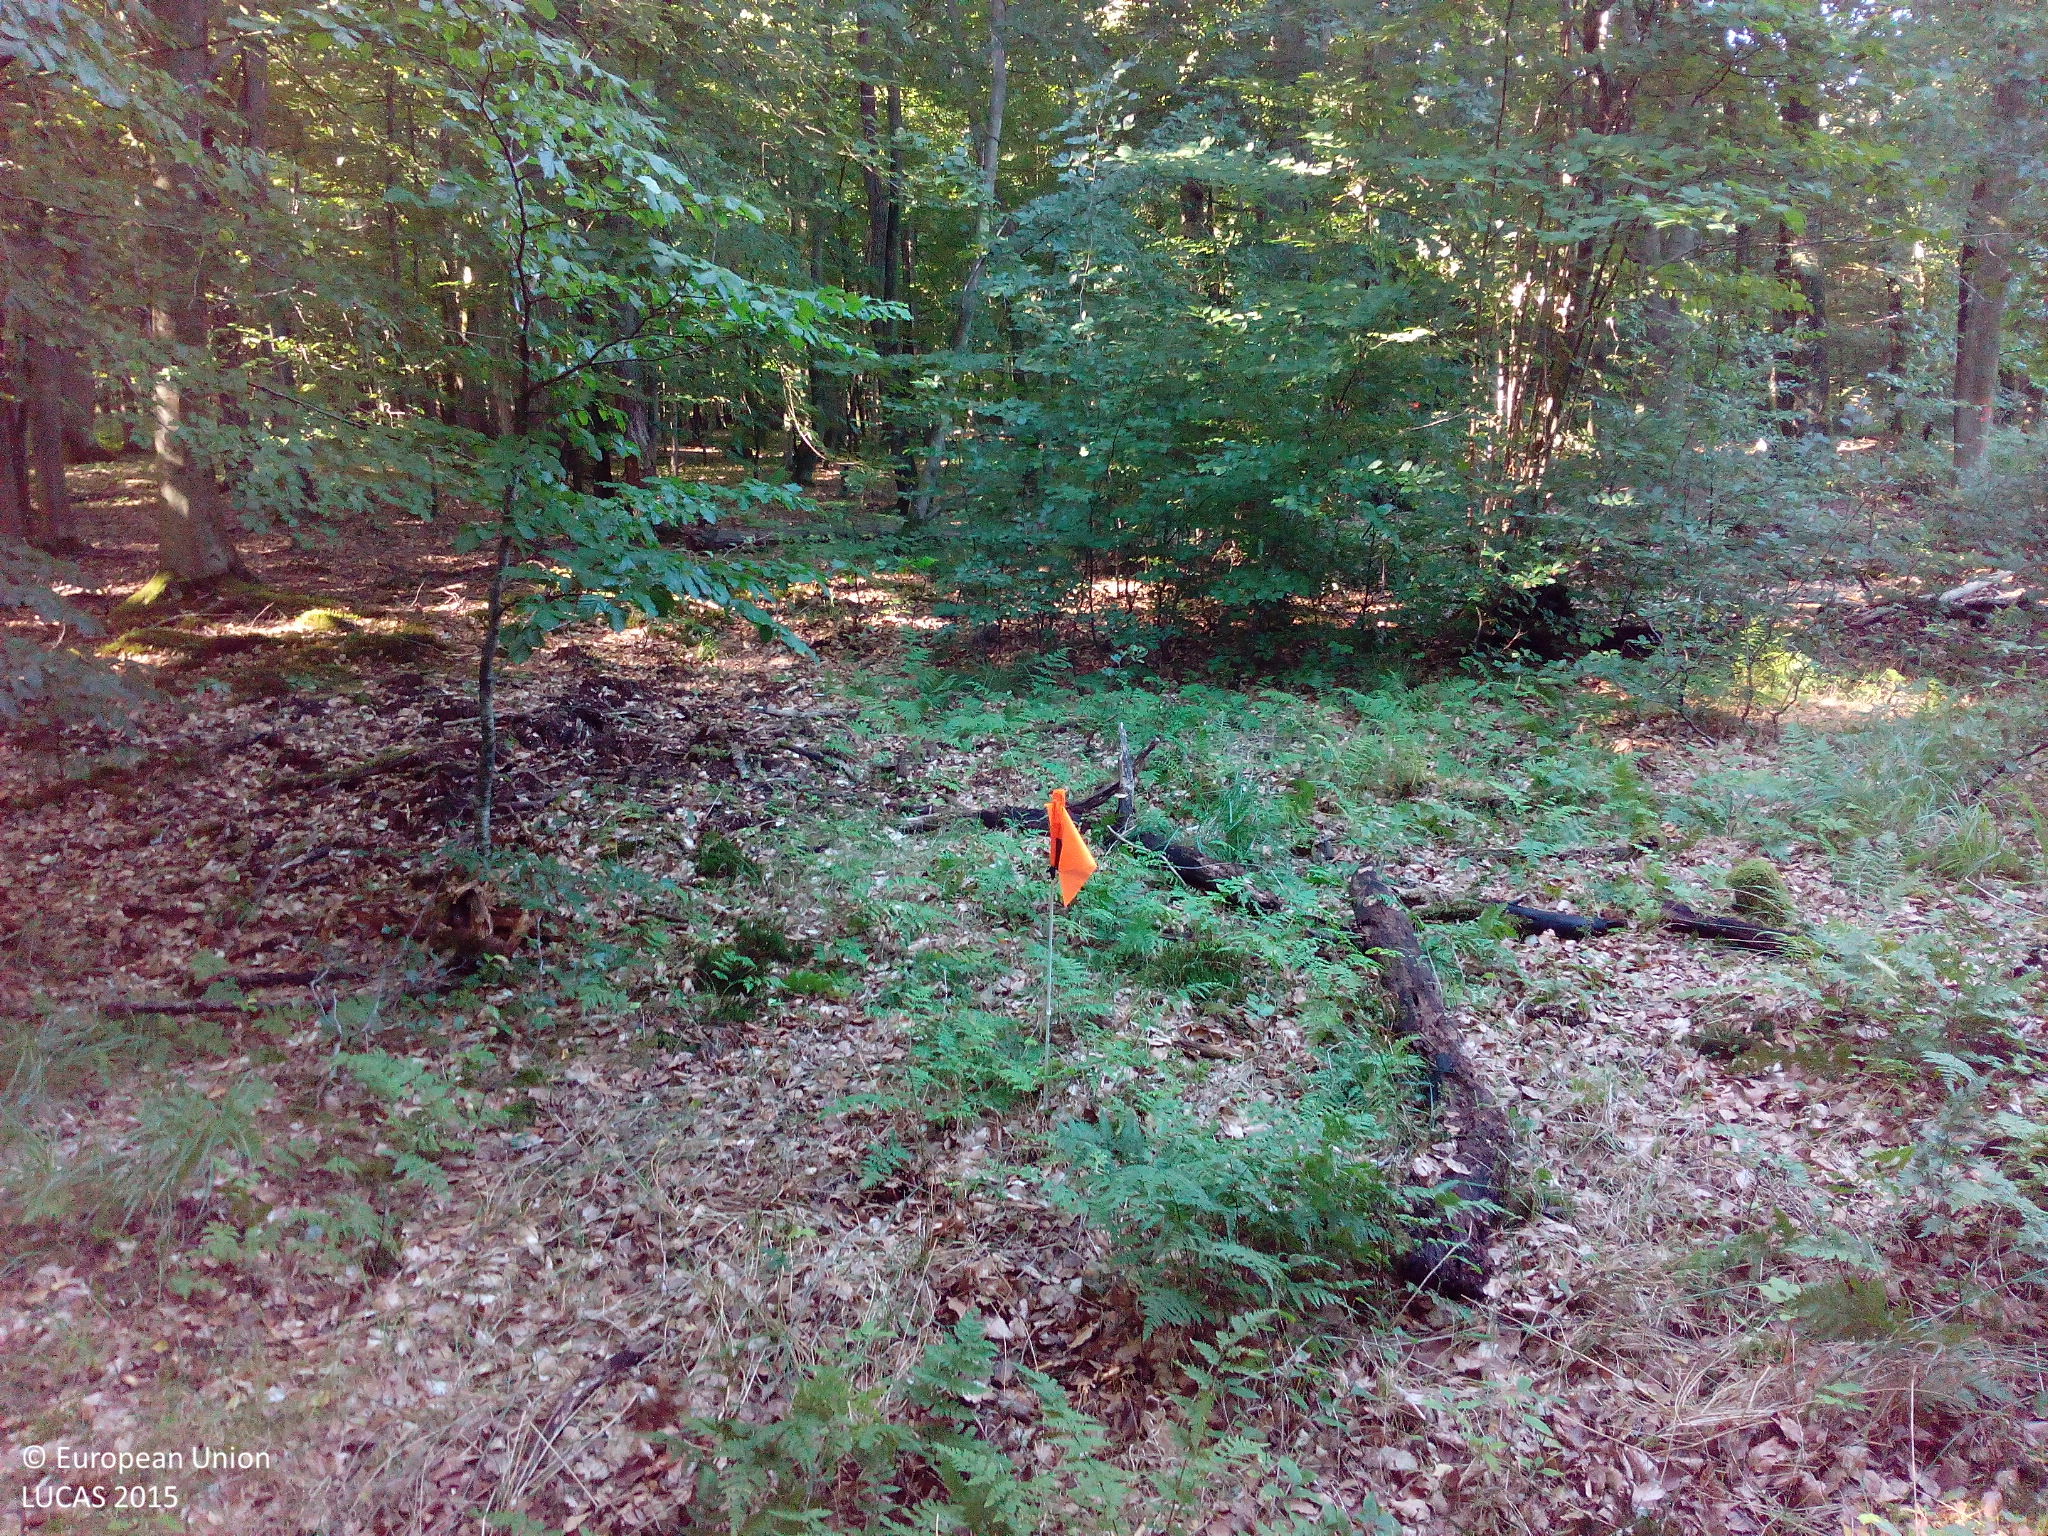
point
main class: Woodland
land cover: Broadleaved woodland
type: beech forest
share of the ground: > 75 %
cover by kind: broadleaved forest trees 85 %, herbaceous plants 10 %, shrubs 5 %
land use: Forestry
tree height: > 5 m
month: September
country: DE
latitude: 54.2064
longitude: 12.3447
